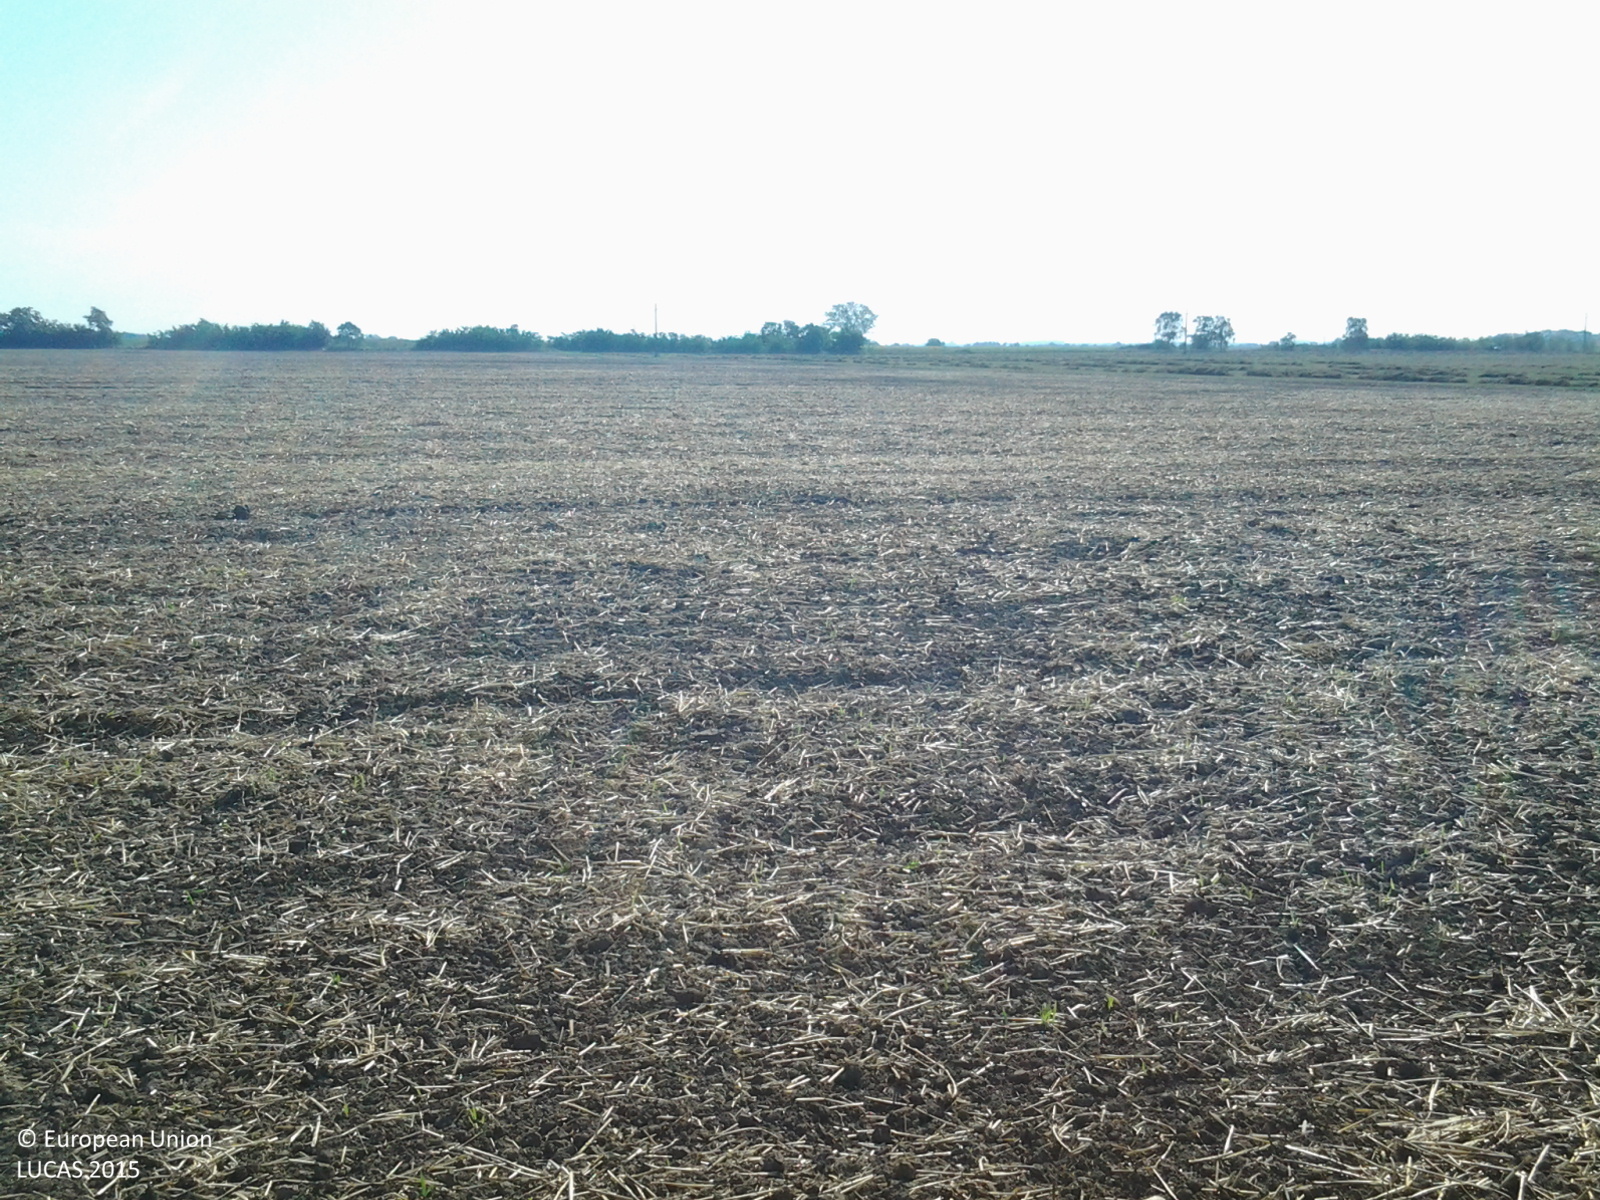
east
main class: Cropland
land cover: Common wheat
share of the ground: < 10 %
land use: Agriculture (excluding fallow land and kitchen gardens)
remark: Harvested field
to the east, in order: Common wheat; Lucerne
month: August
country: HU
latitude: 46.9282
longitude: 21.5057
